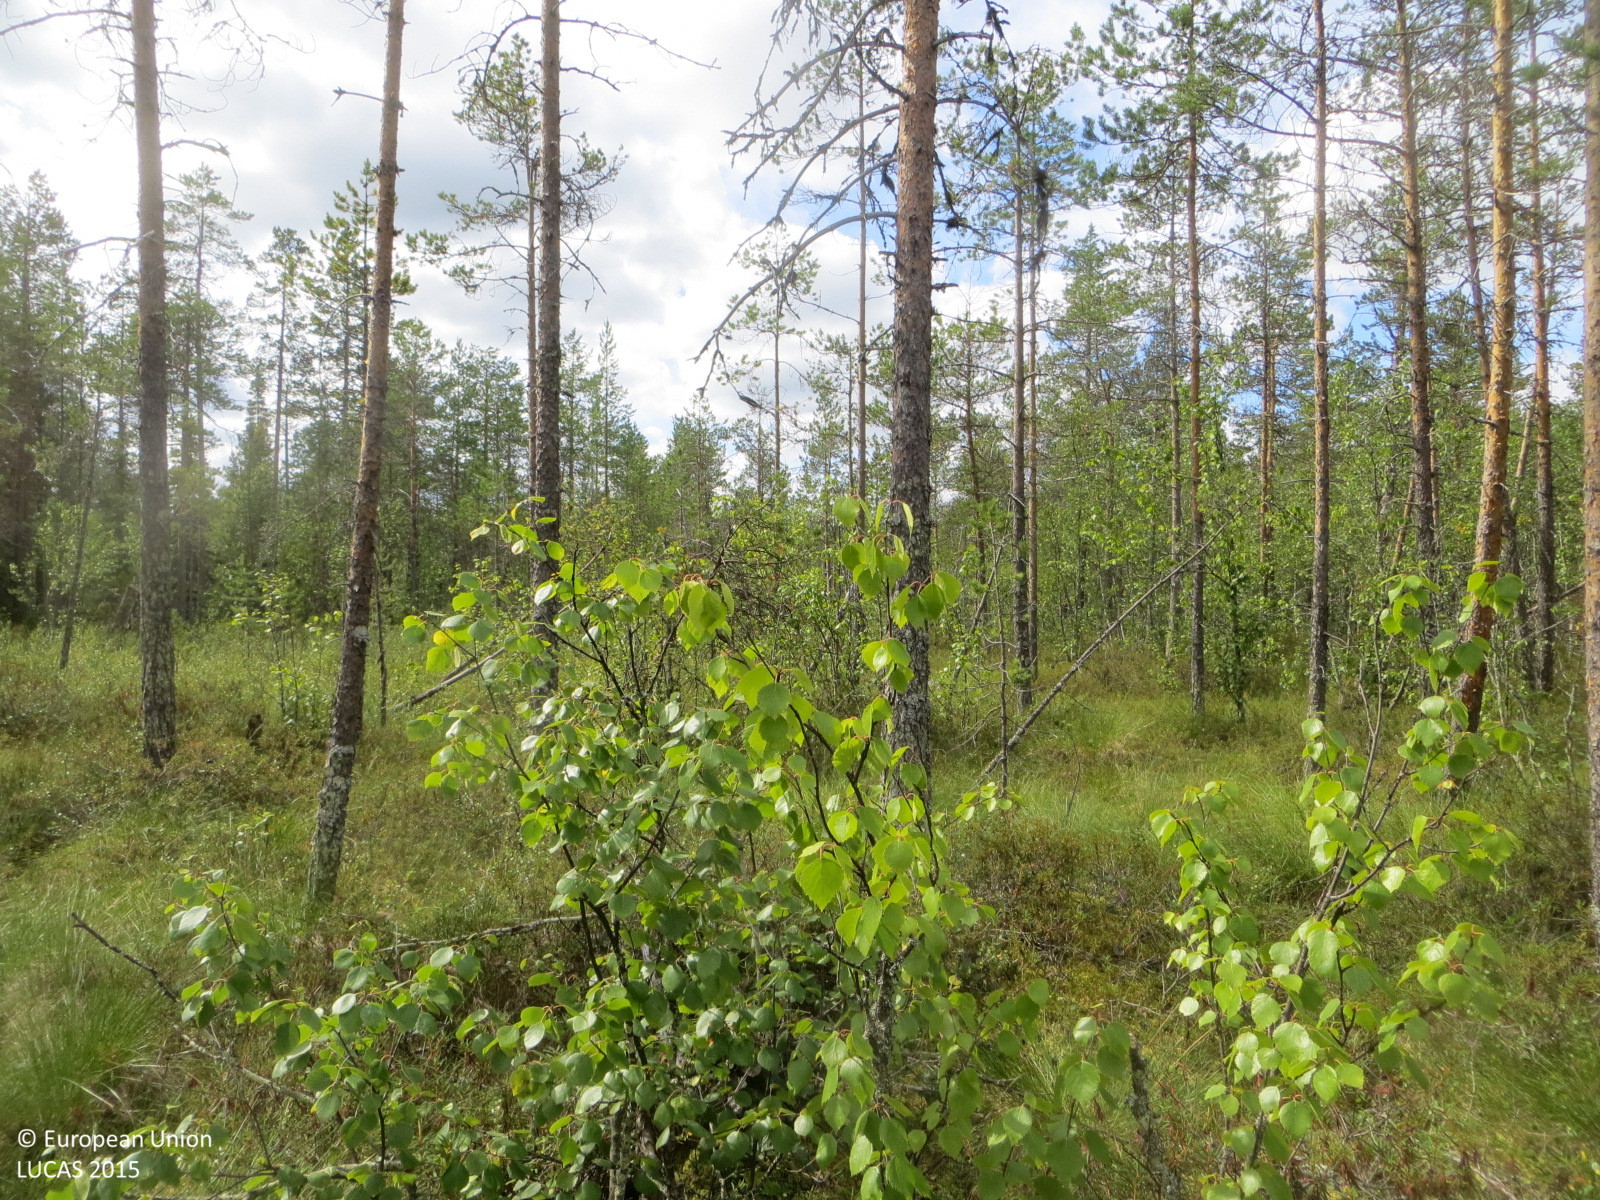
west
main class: Woodland
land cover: Pine dominated coniferous woodland
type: mire and swamp forests
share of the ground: 50 - 75 %
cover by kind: coniferous forest trees 50 %, shrubs 45 %, broadleaved forest trees 5 %
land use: Forestry
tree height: > 5 m
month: August
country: FI
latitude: 66.1886
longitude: 25.4499
